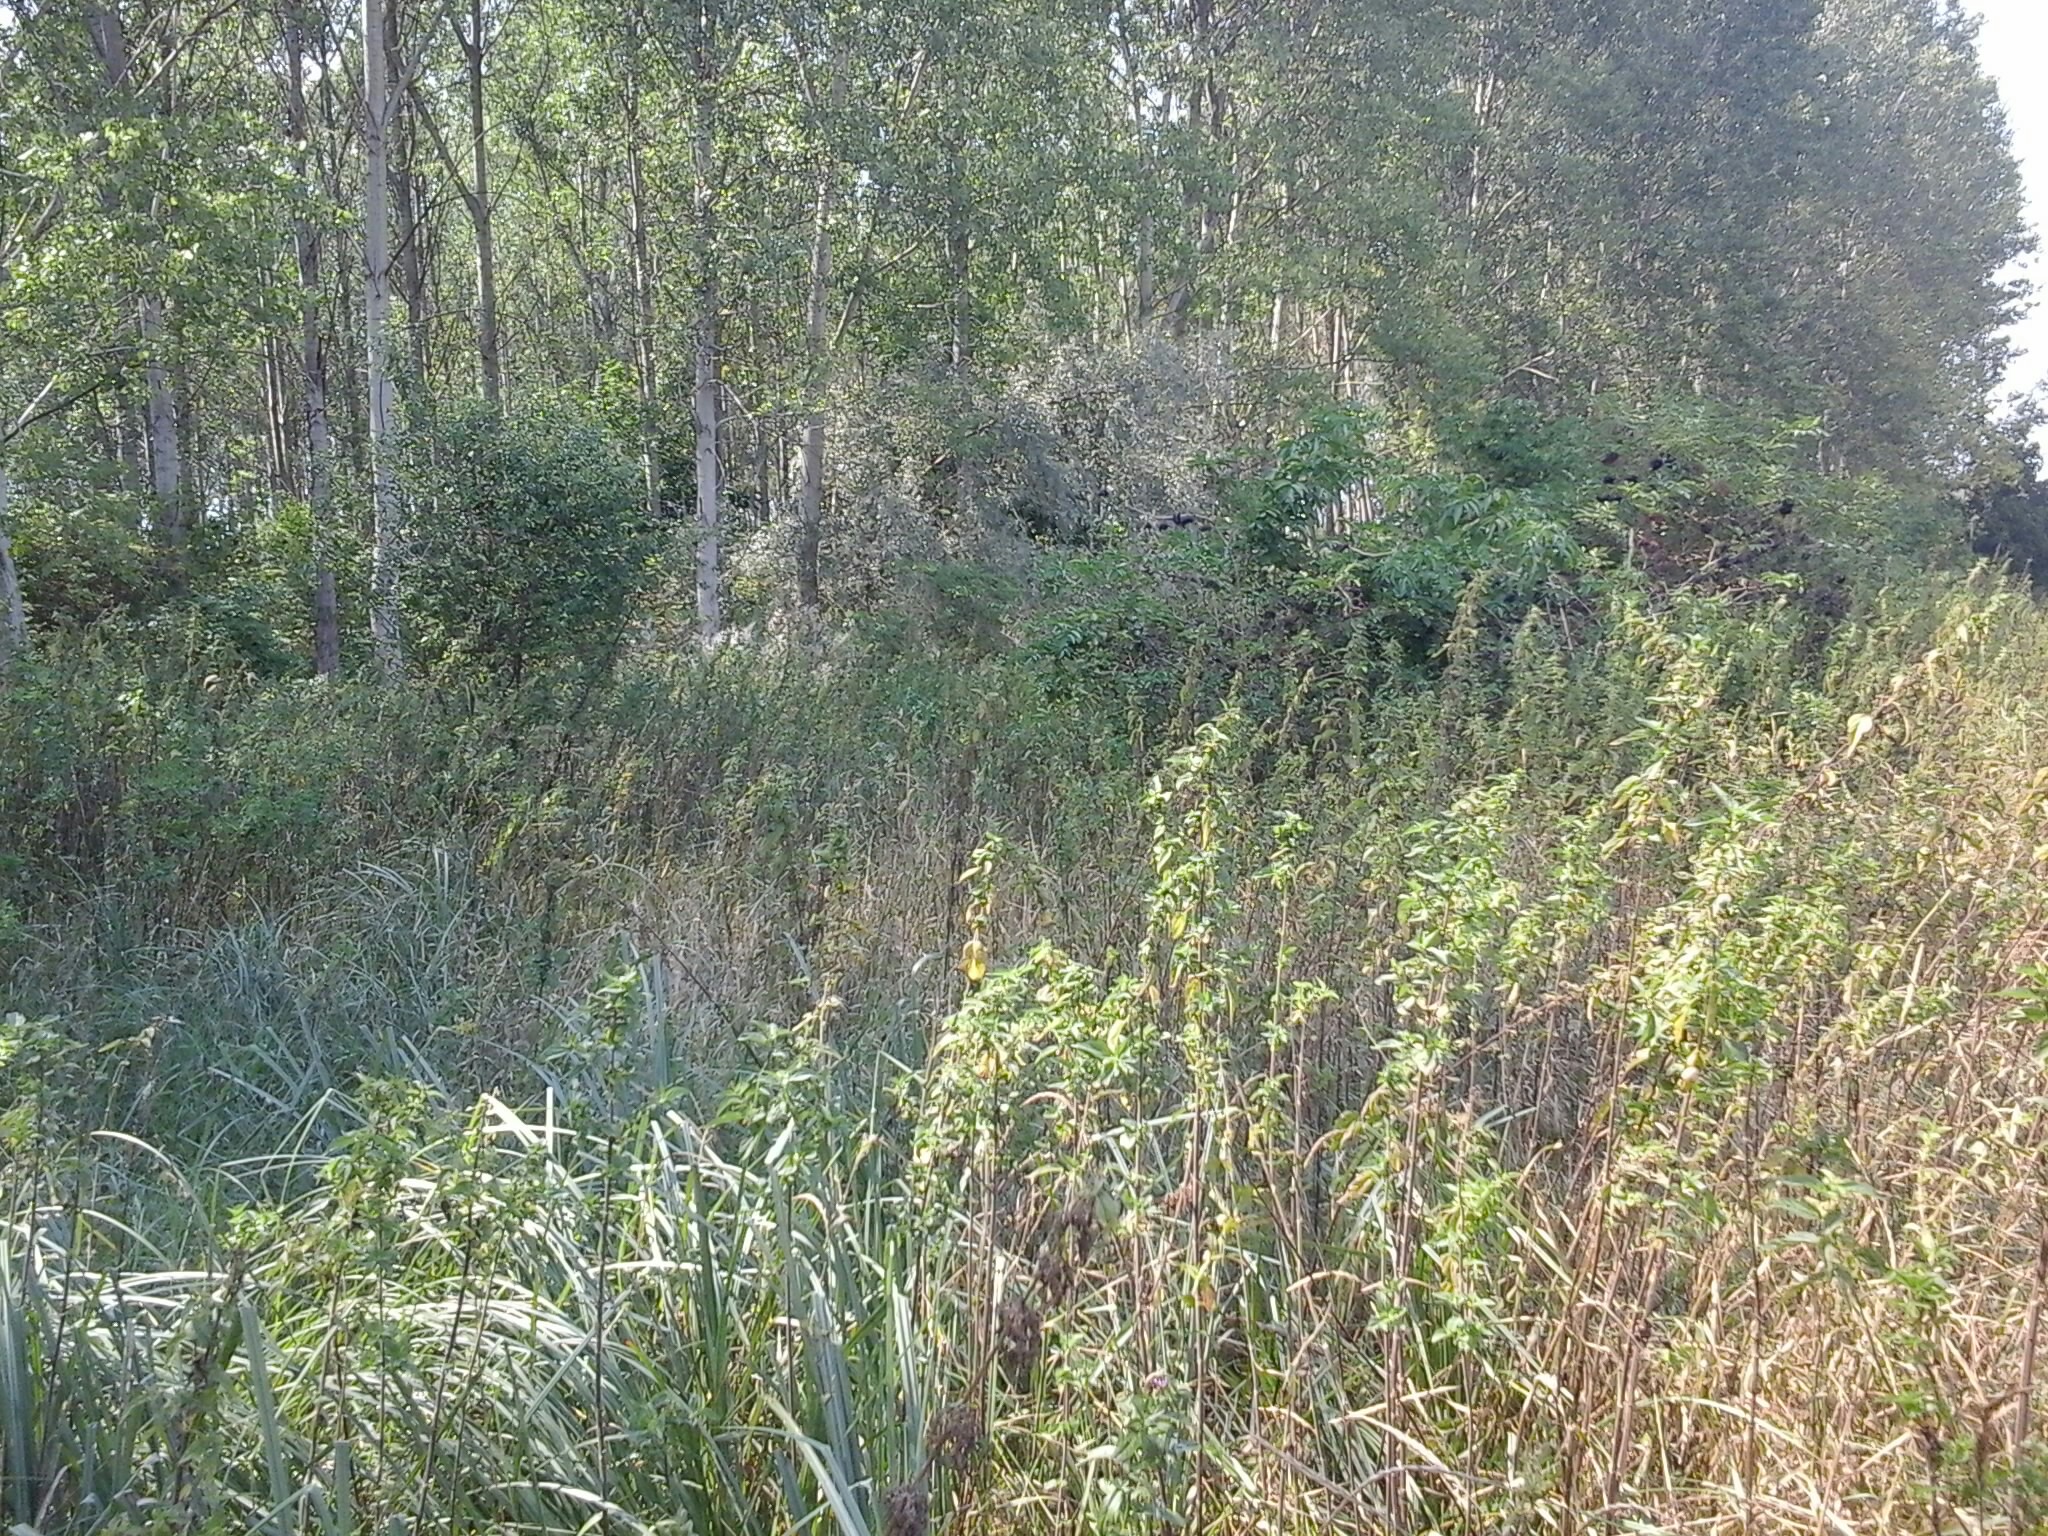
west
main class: Grassland
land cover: Grassland with sparse tree/shrub cover
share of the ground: > 75 %
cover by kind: herbaceous plants 95 %, broadleaved forest trees 5 %
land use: Semi-natural and natural areas not in use
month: August
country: HU
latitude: 48.0389
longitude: 19.1816
